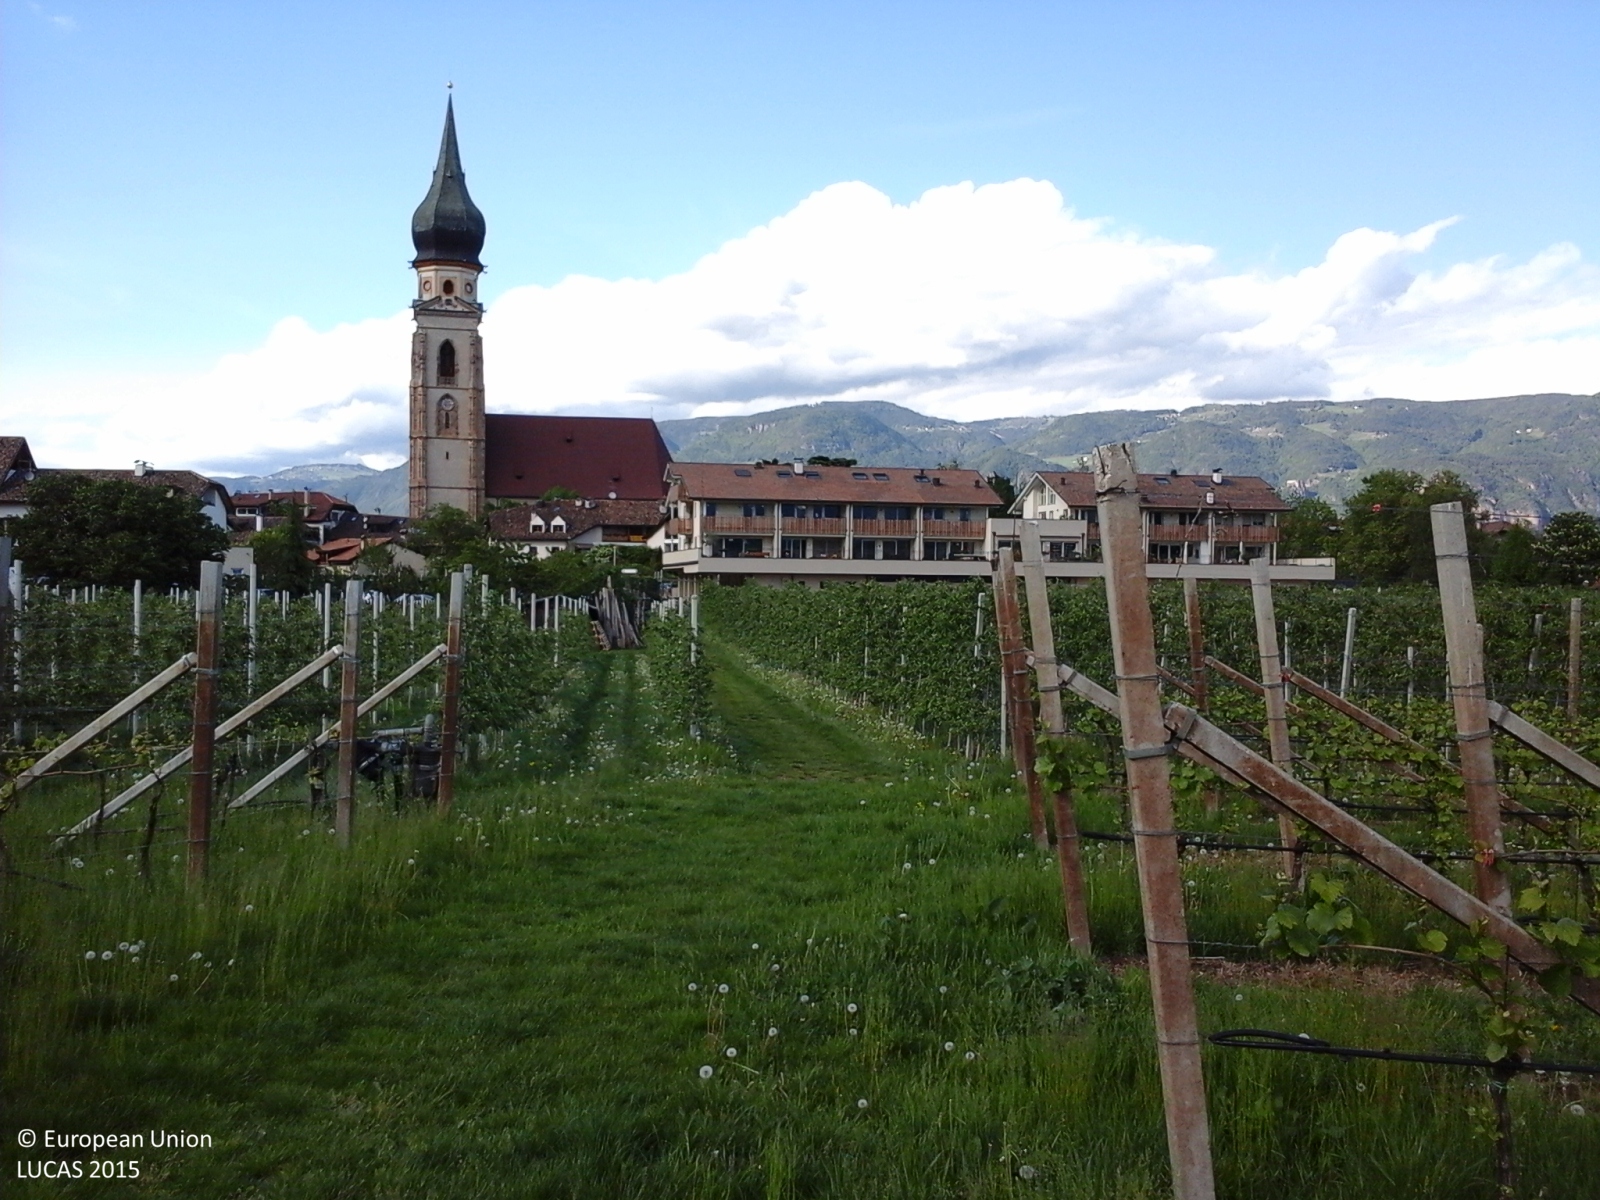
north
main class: Cropland
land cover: Vineyards
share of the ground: 50 - 75 %
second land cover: Grassland without tree/shrub cover
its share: 50 - 75 %
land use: Agriculture (excluding fallow land and kitchen gardens)
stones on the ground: < 10 %
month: April
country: IT
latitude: 46.4699
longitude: 11.2617
